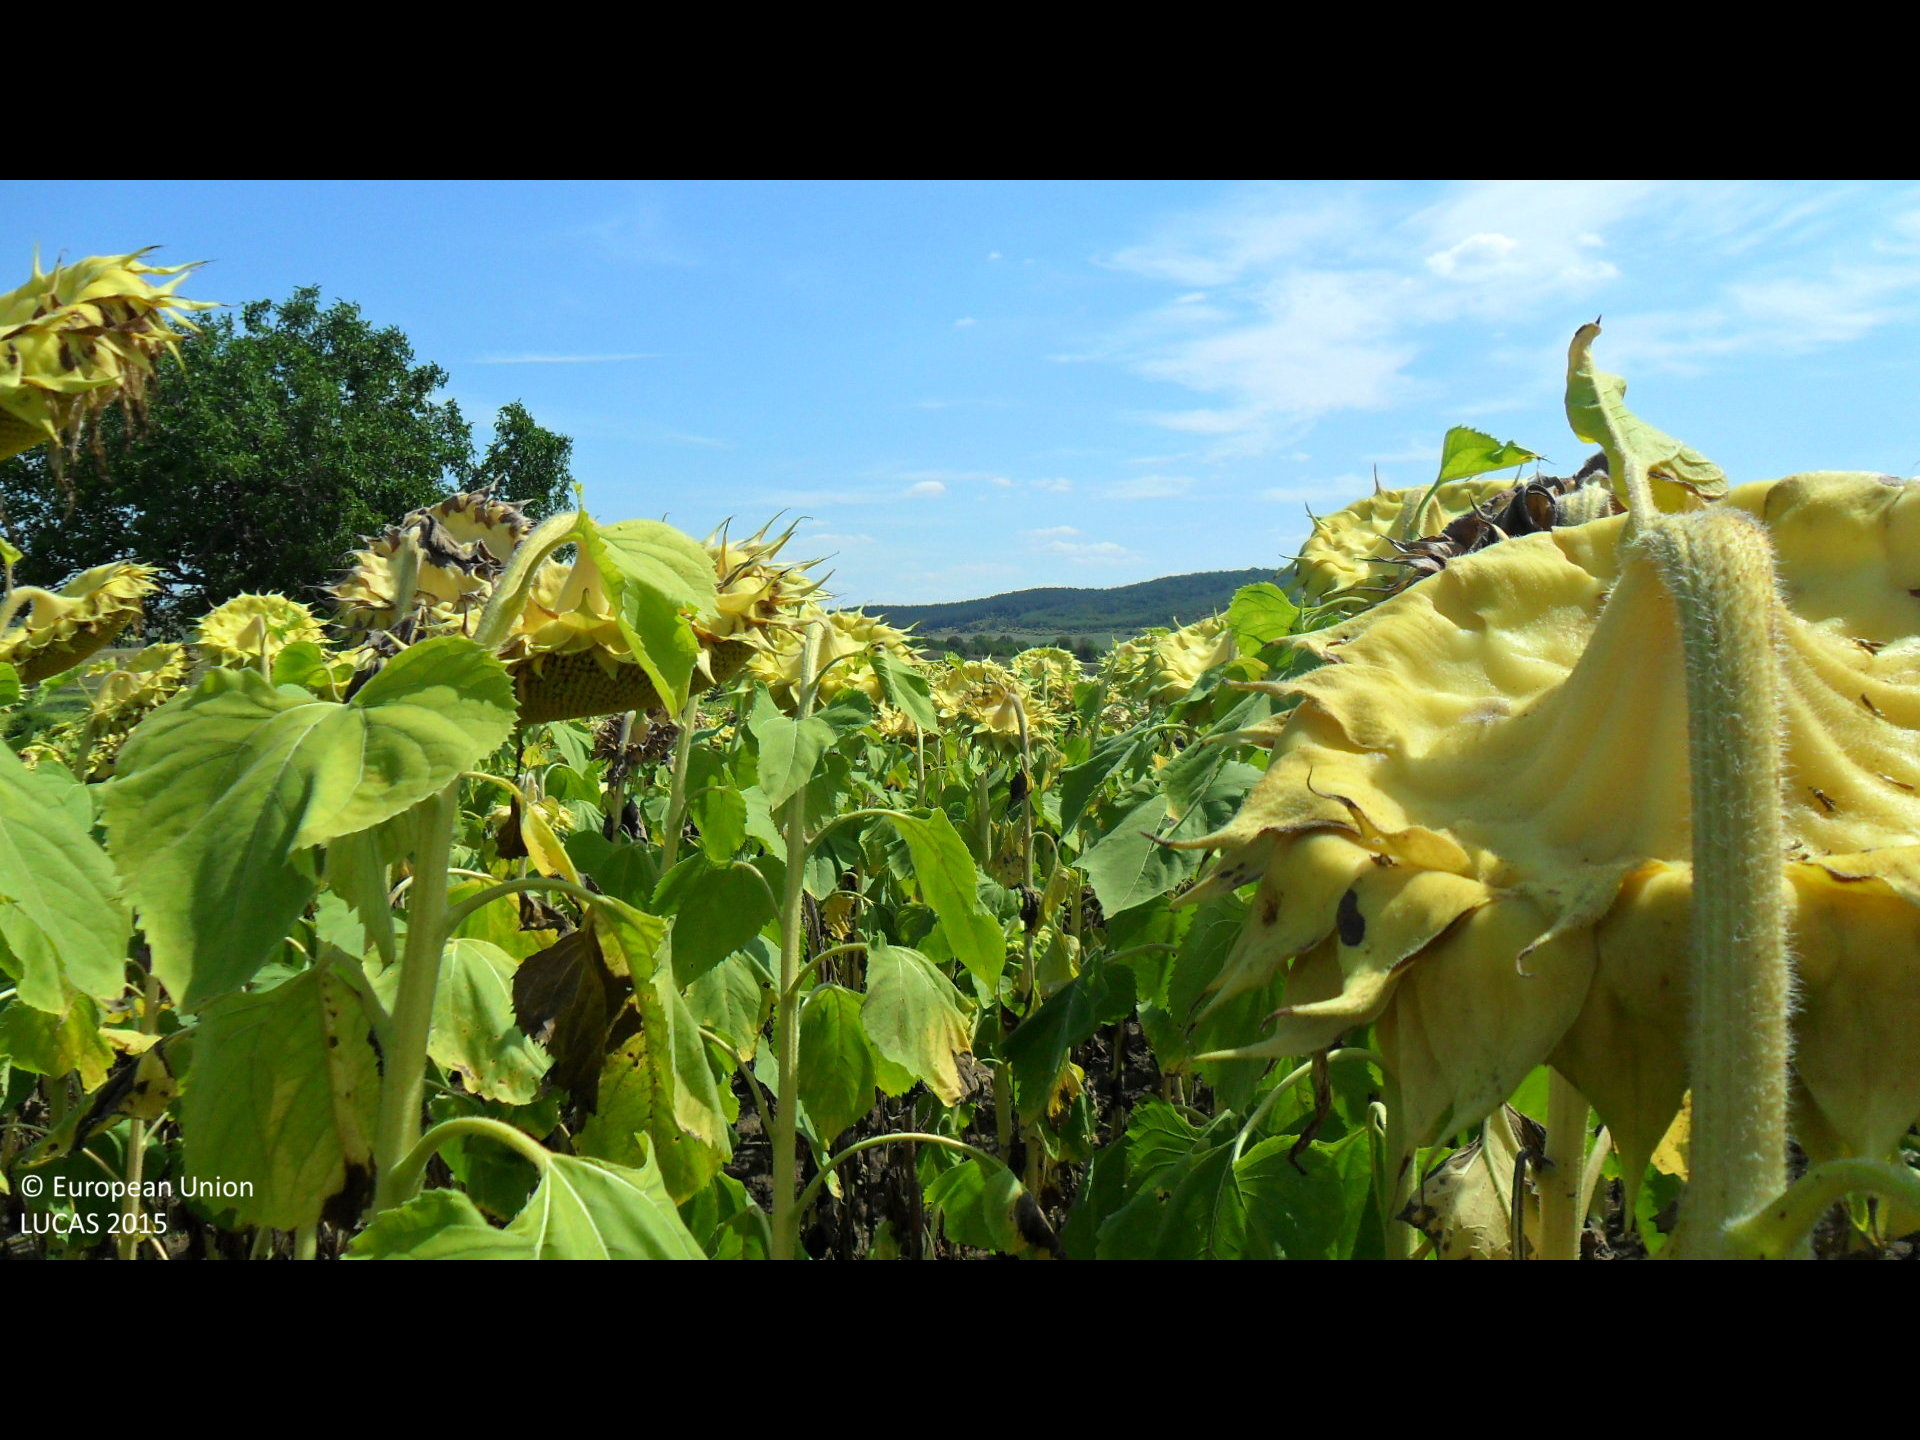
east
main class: Cropland
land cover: Sunflower
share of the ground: > 75 %
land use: Agriculture (excluding fallow land and kitchen gardens)
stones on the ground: < 10 %
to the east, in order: Sunflower; Tracks; Sunflower
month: August
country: BG
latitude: 43.3751
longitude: 26.4553
